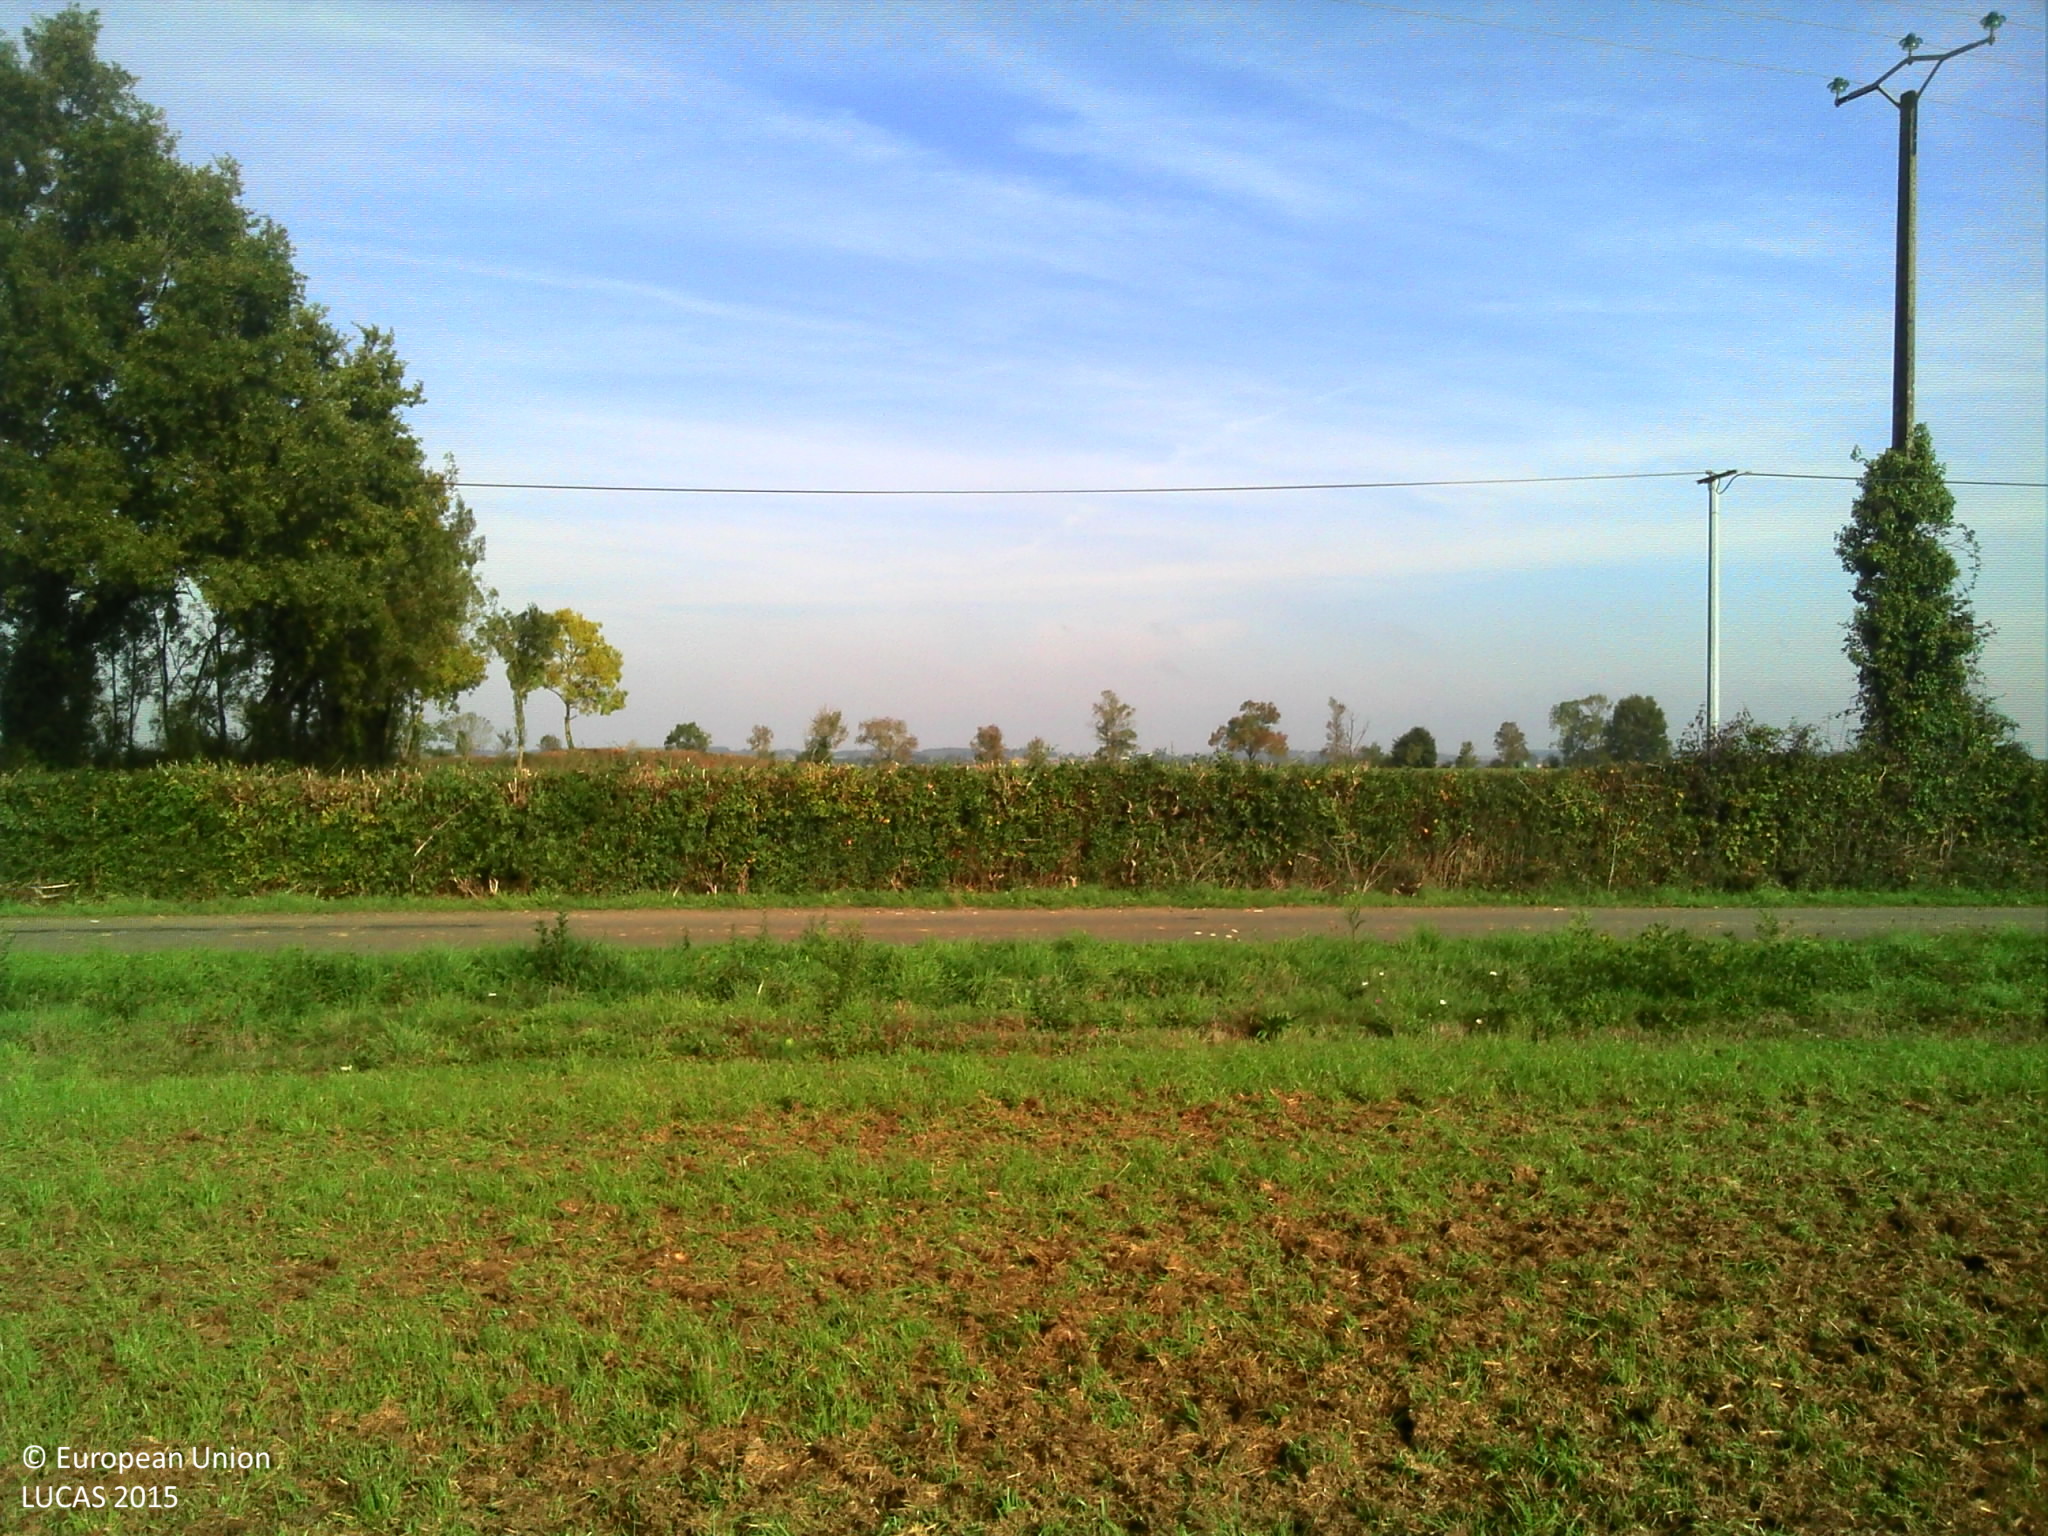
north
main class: Cropland
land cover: Temporary grasslands
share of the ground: > 75 %
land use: Agriculture (excluding fallow land and kitchen gardens)
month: October
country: FR
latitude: 47.1862
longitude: -0.9485
